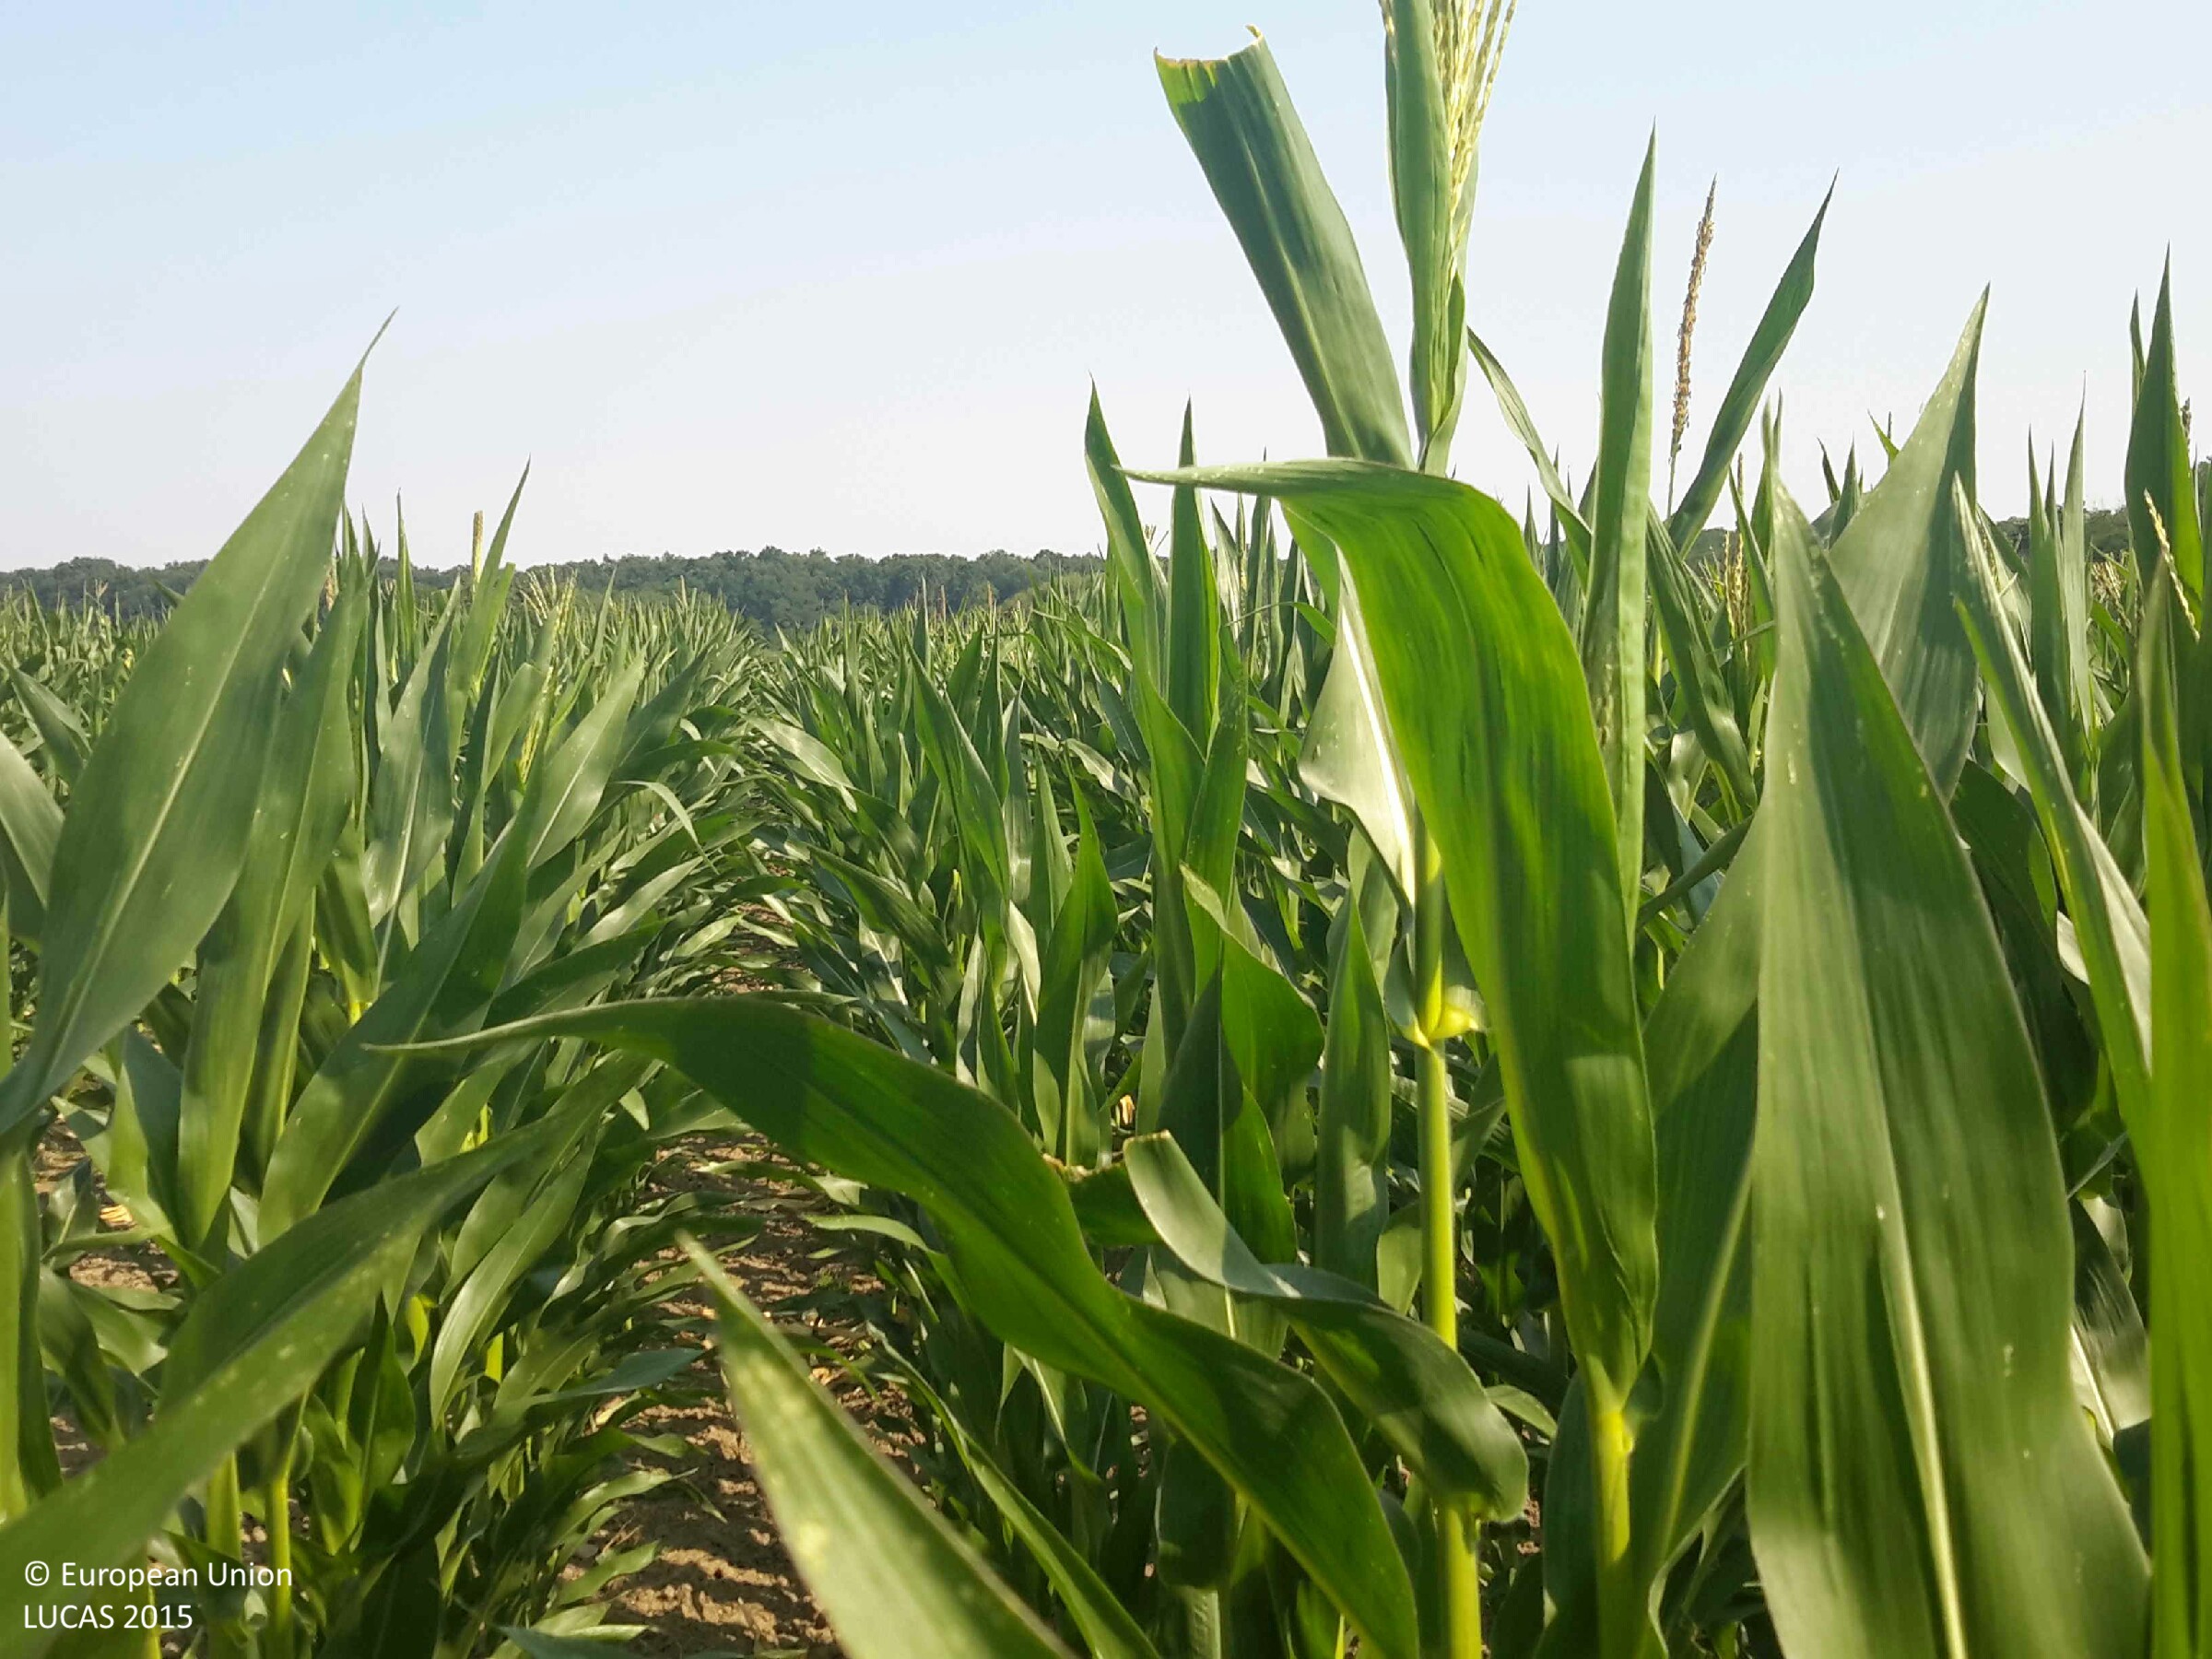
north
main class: Cropland
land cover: Maize
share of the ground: > 75 %
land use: Agriculture (excluding fallow land and kitchen gardens)
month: July
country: HU
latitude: 47.2127
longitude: 17.1752
